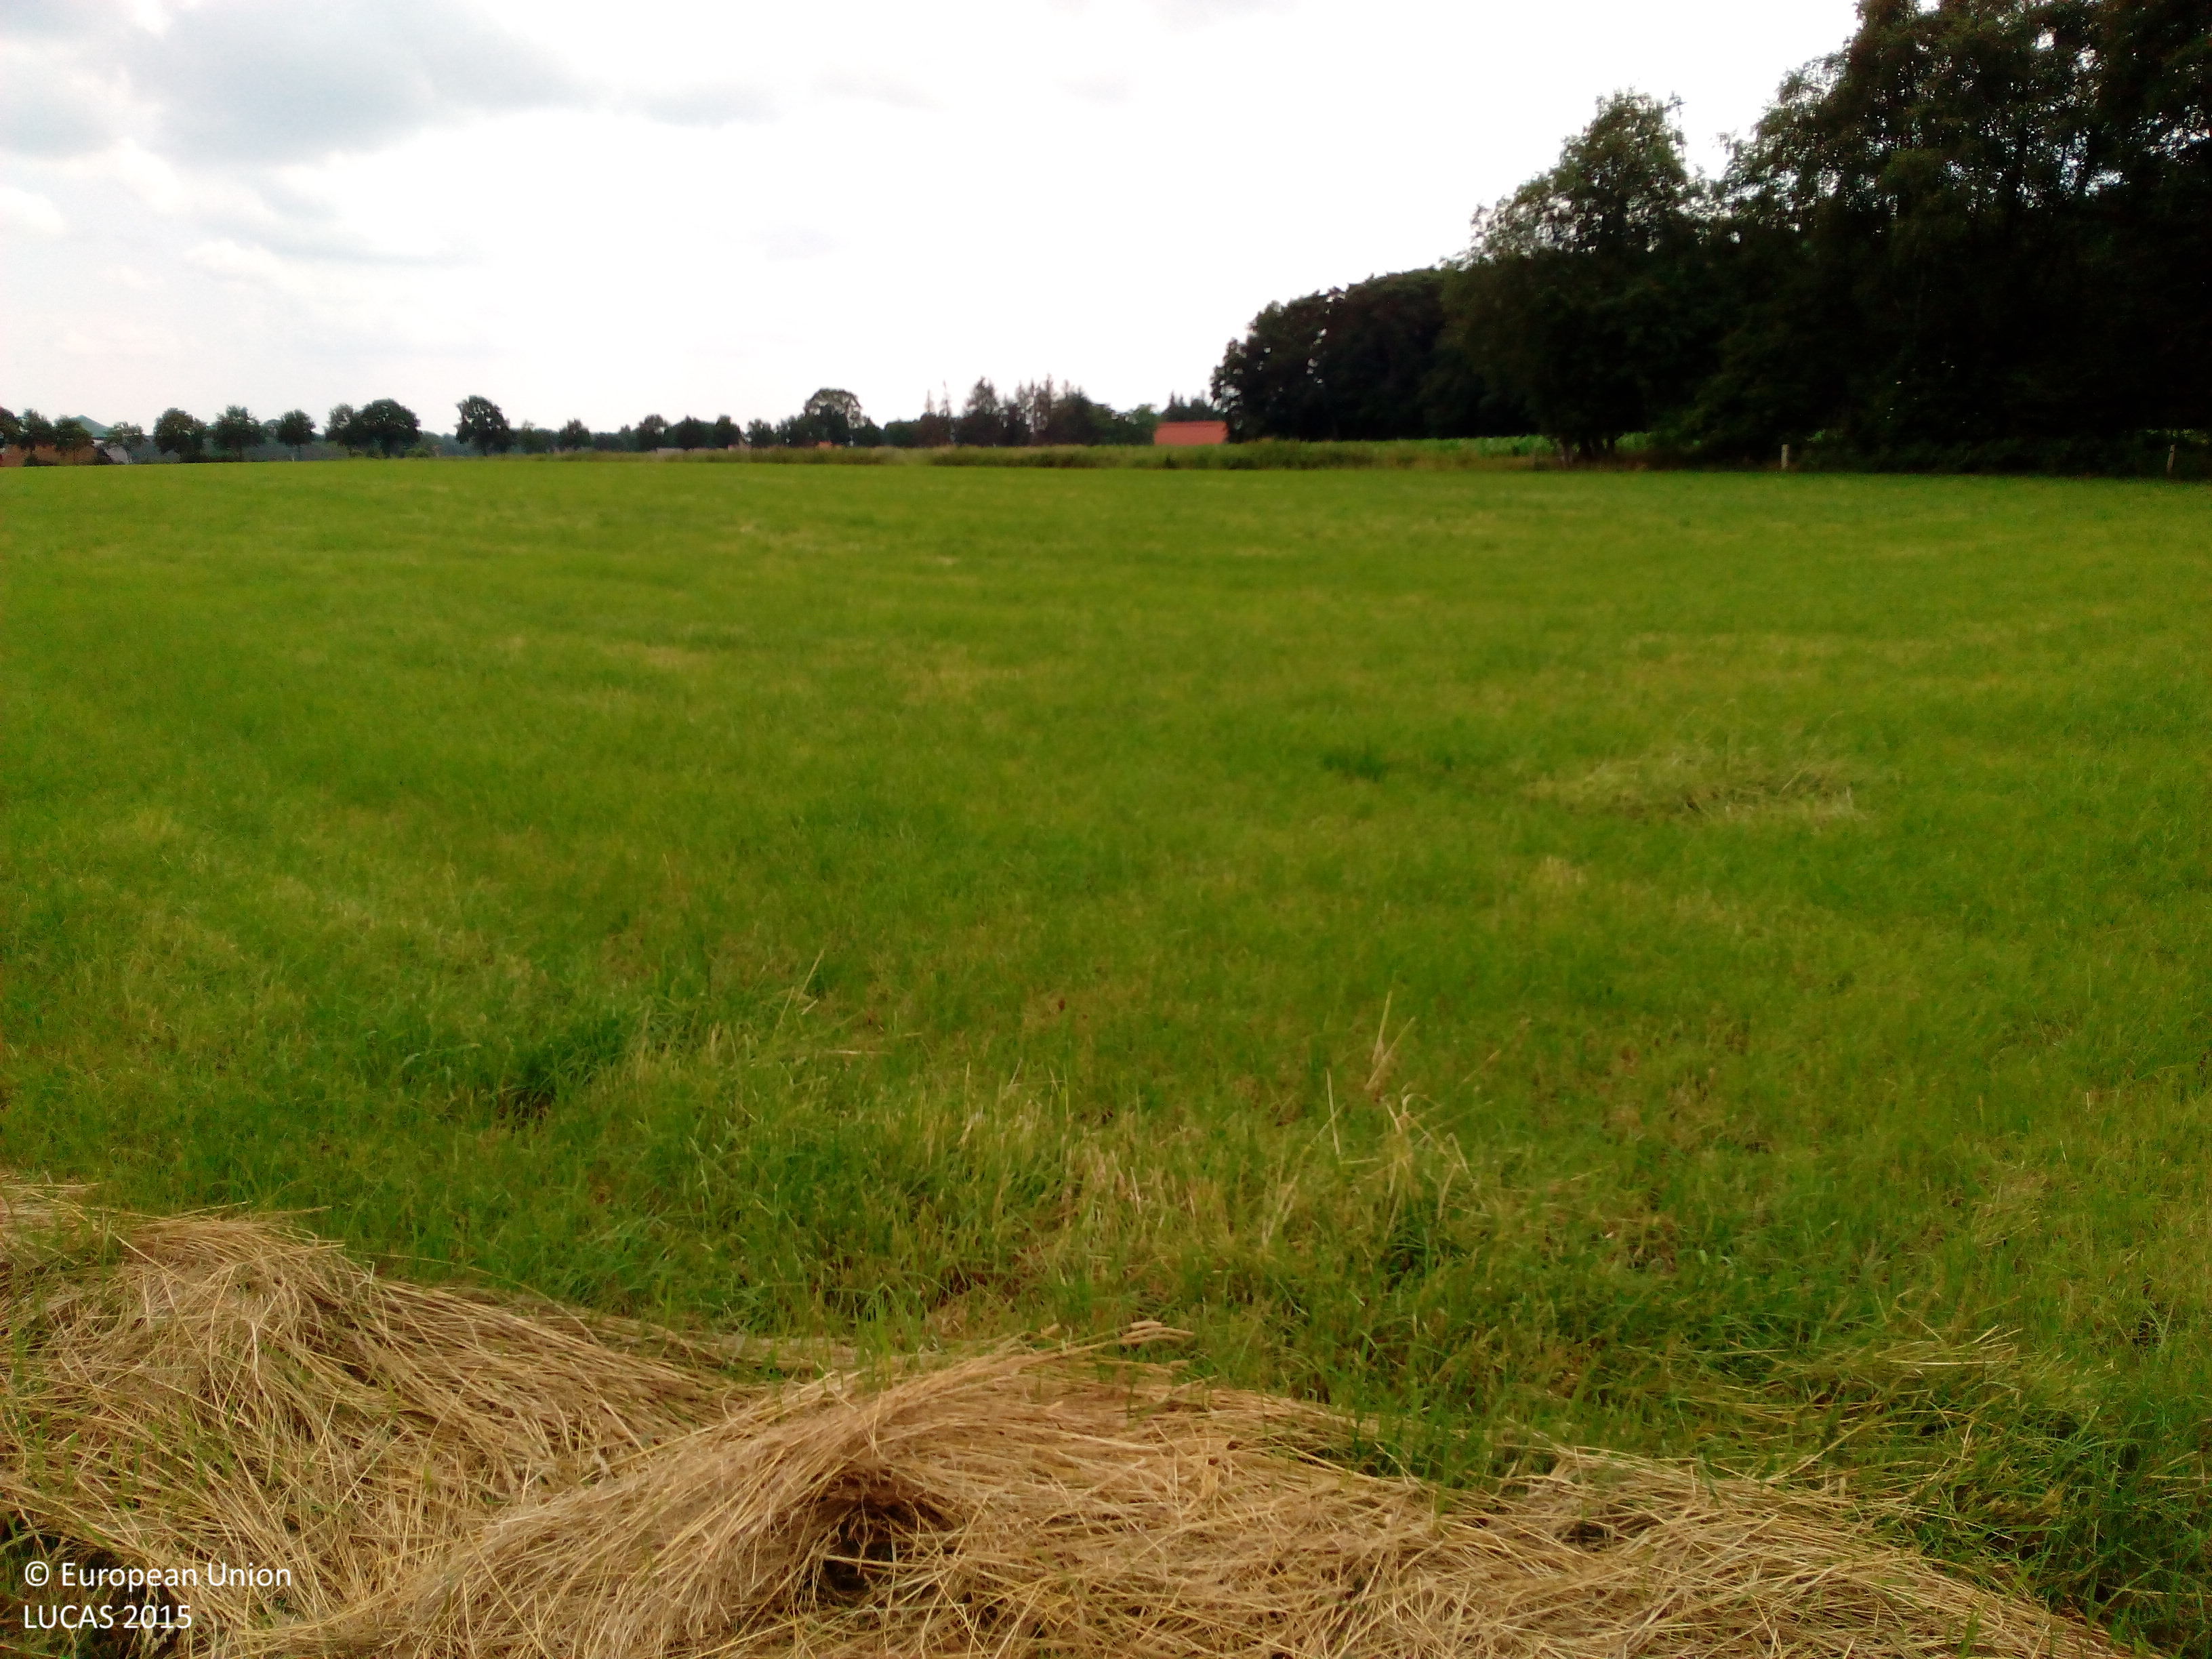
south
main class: Grassland
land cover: Grassland without tree/shrub cover
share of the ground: > 75 %
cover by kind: herbaceous plants 100 %
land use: Agriculture (excluding fallow land and kitchen gardens)
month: July
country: DE
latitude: 53.3126
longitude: 7.9444
